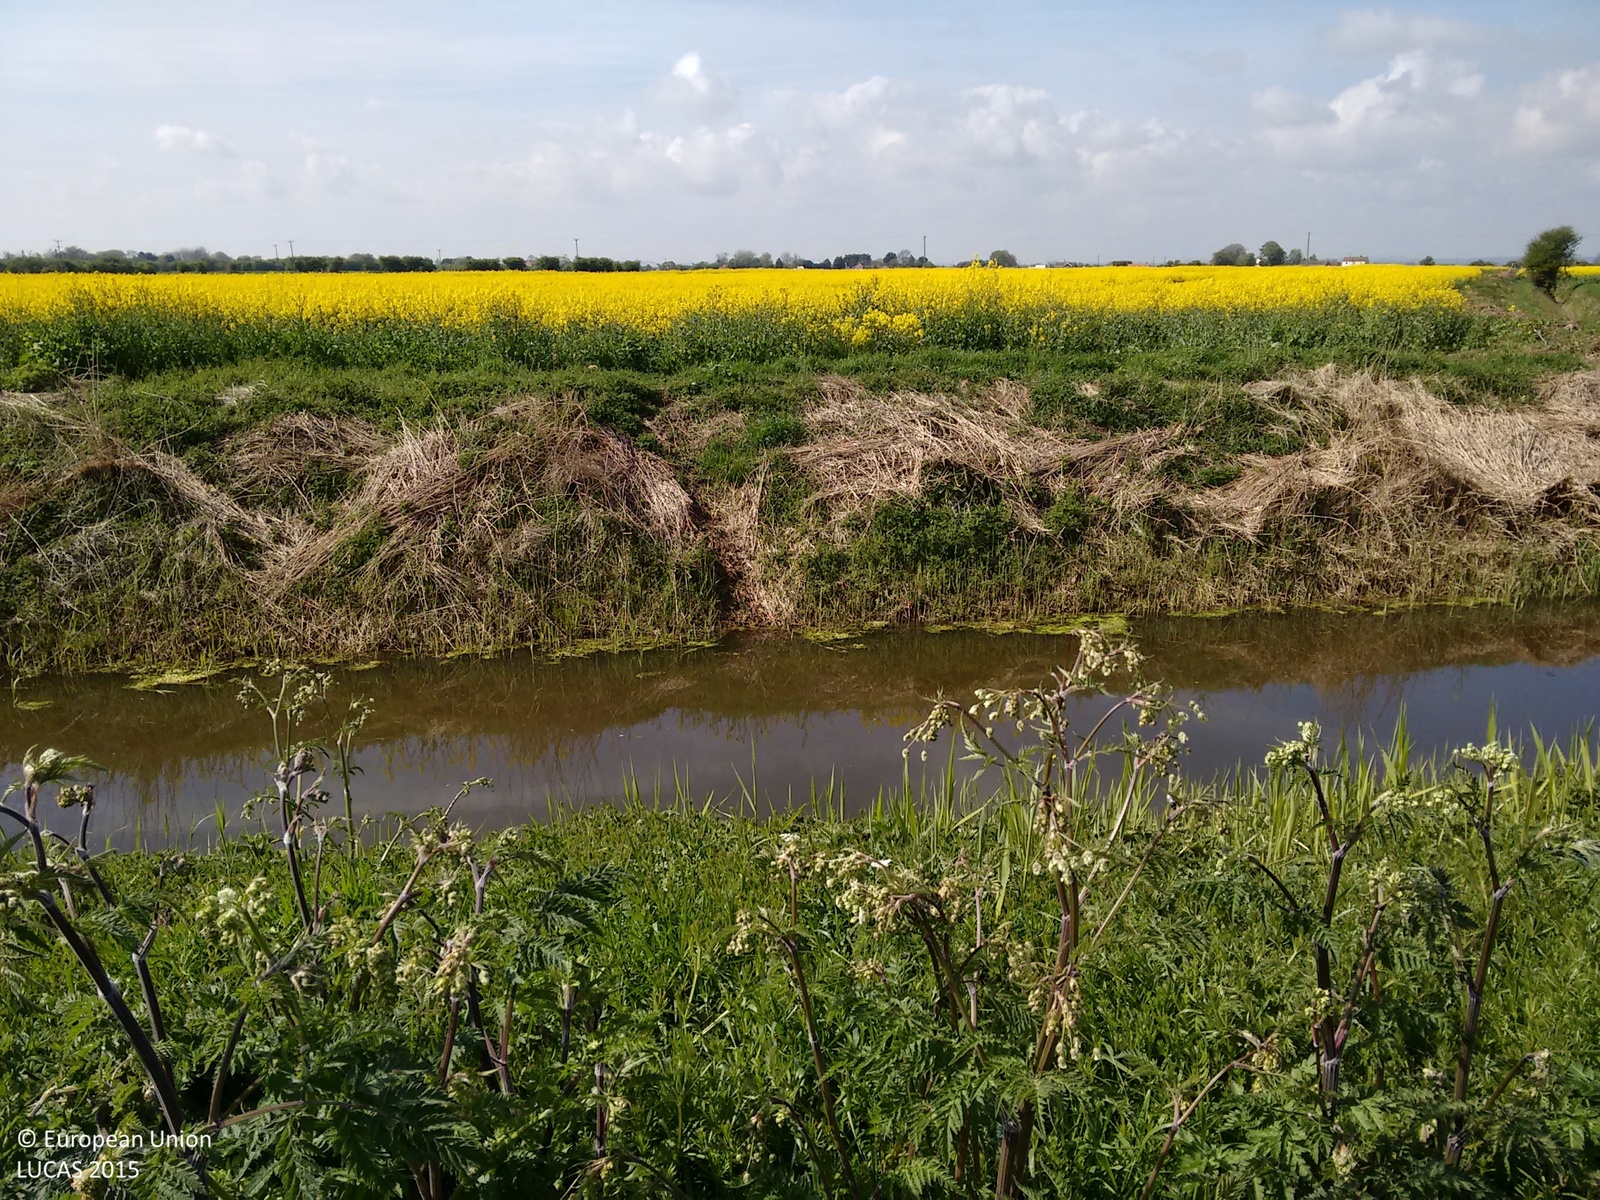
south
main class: Cropland
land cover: Rape and turnip rape
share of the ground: > 75 %
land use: Agriculture (excluding fallow land and kitchen gardens)
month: May
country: GB
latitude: 53.3672
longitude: 0.2169
